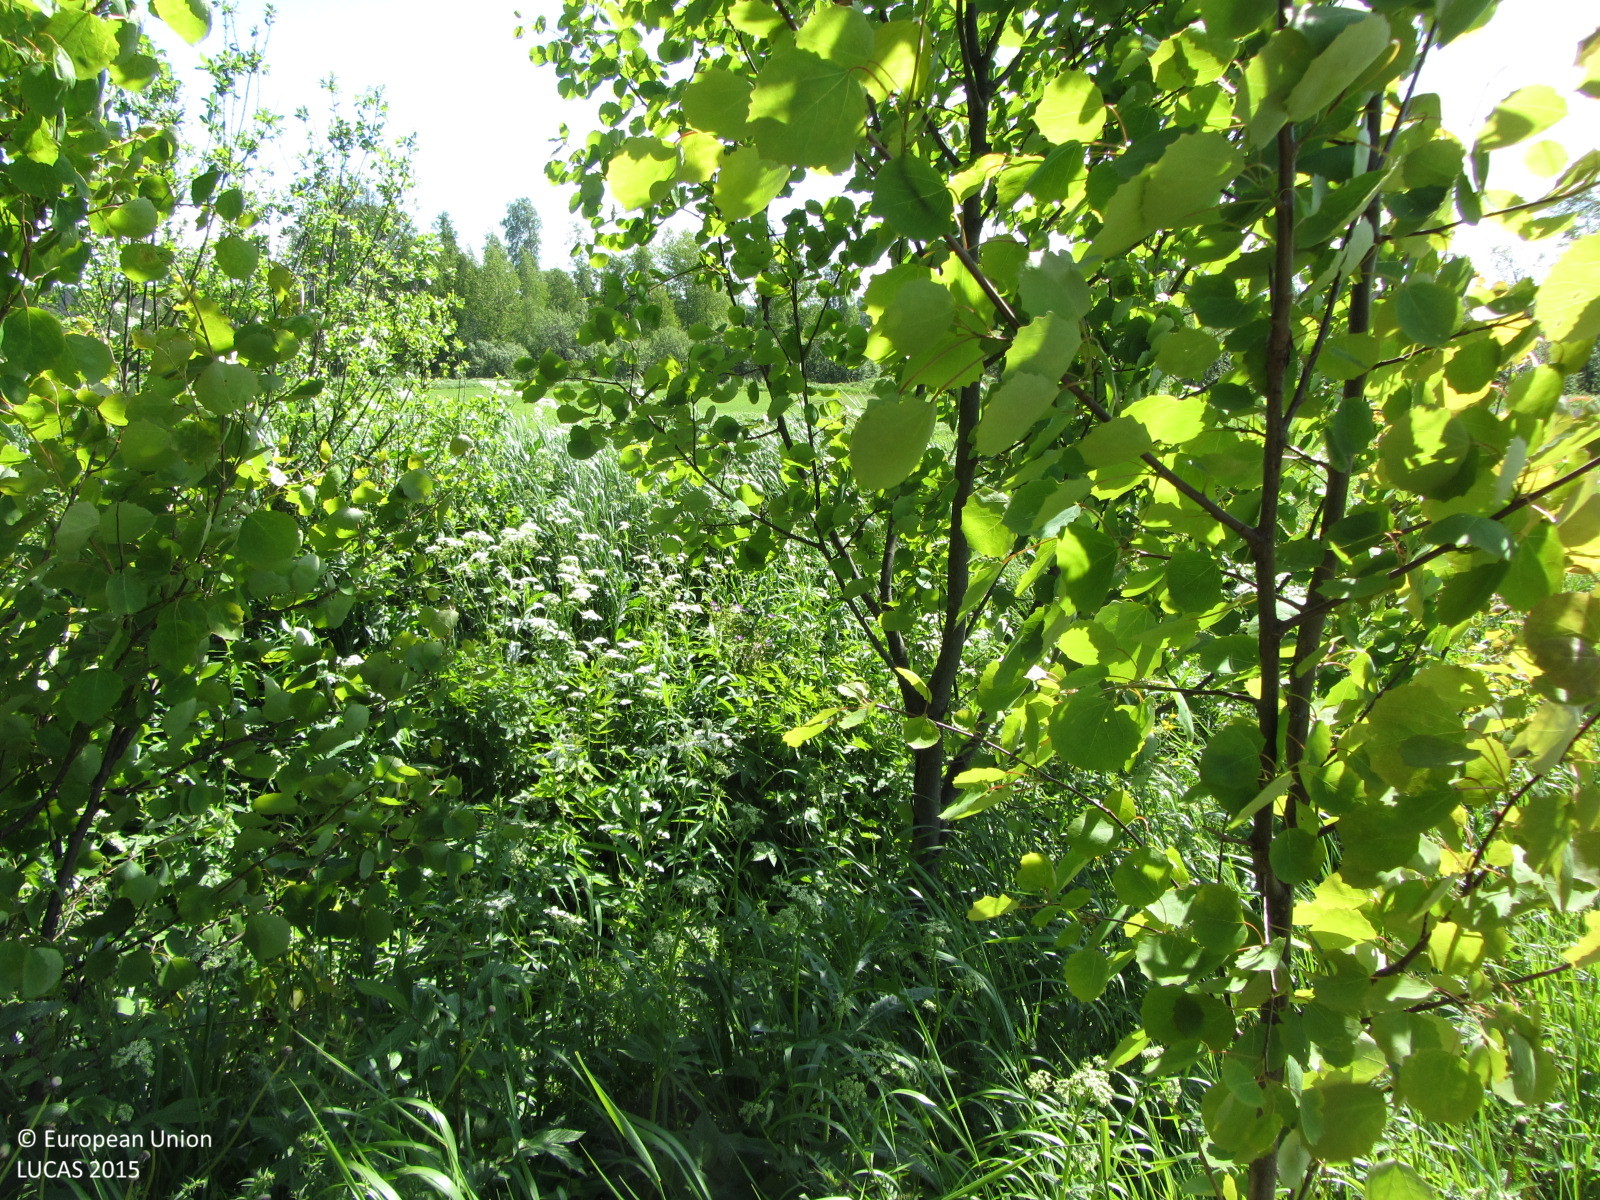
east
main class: Grassland
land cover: Grassland with sparse tree/shrub cover
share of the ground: > 75 %
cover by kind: herbaceous plants 90 %, broadleaved forest trees 5 %, shrubs 5 %
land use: Agriculture (excluding fallow land and kitchen gardens)
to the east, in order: Grassland with sparse tree/shrub cover; Ditches and canals; Grass margins; Ditches and canals; Oats; Ditches and canals; Oats; Ditches and canals; Oats; Grass margins; Inland fresh running water; Broadleaved woodland; Ditches and canals; Broadleaved woodland
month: June
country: FI
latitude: 60.1986
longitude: 24.3005
